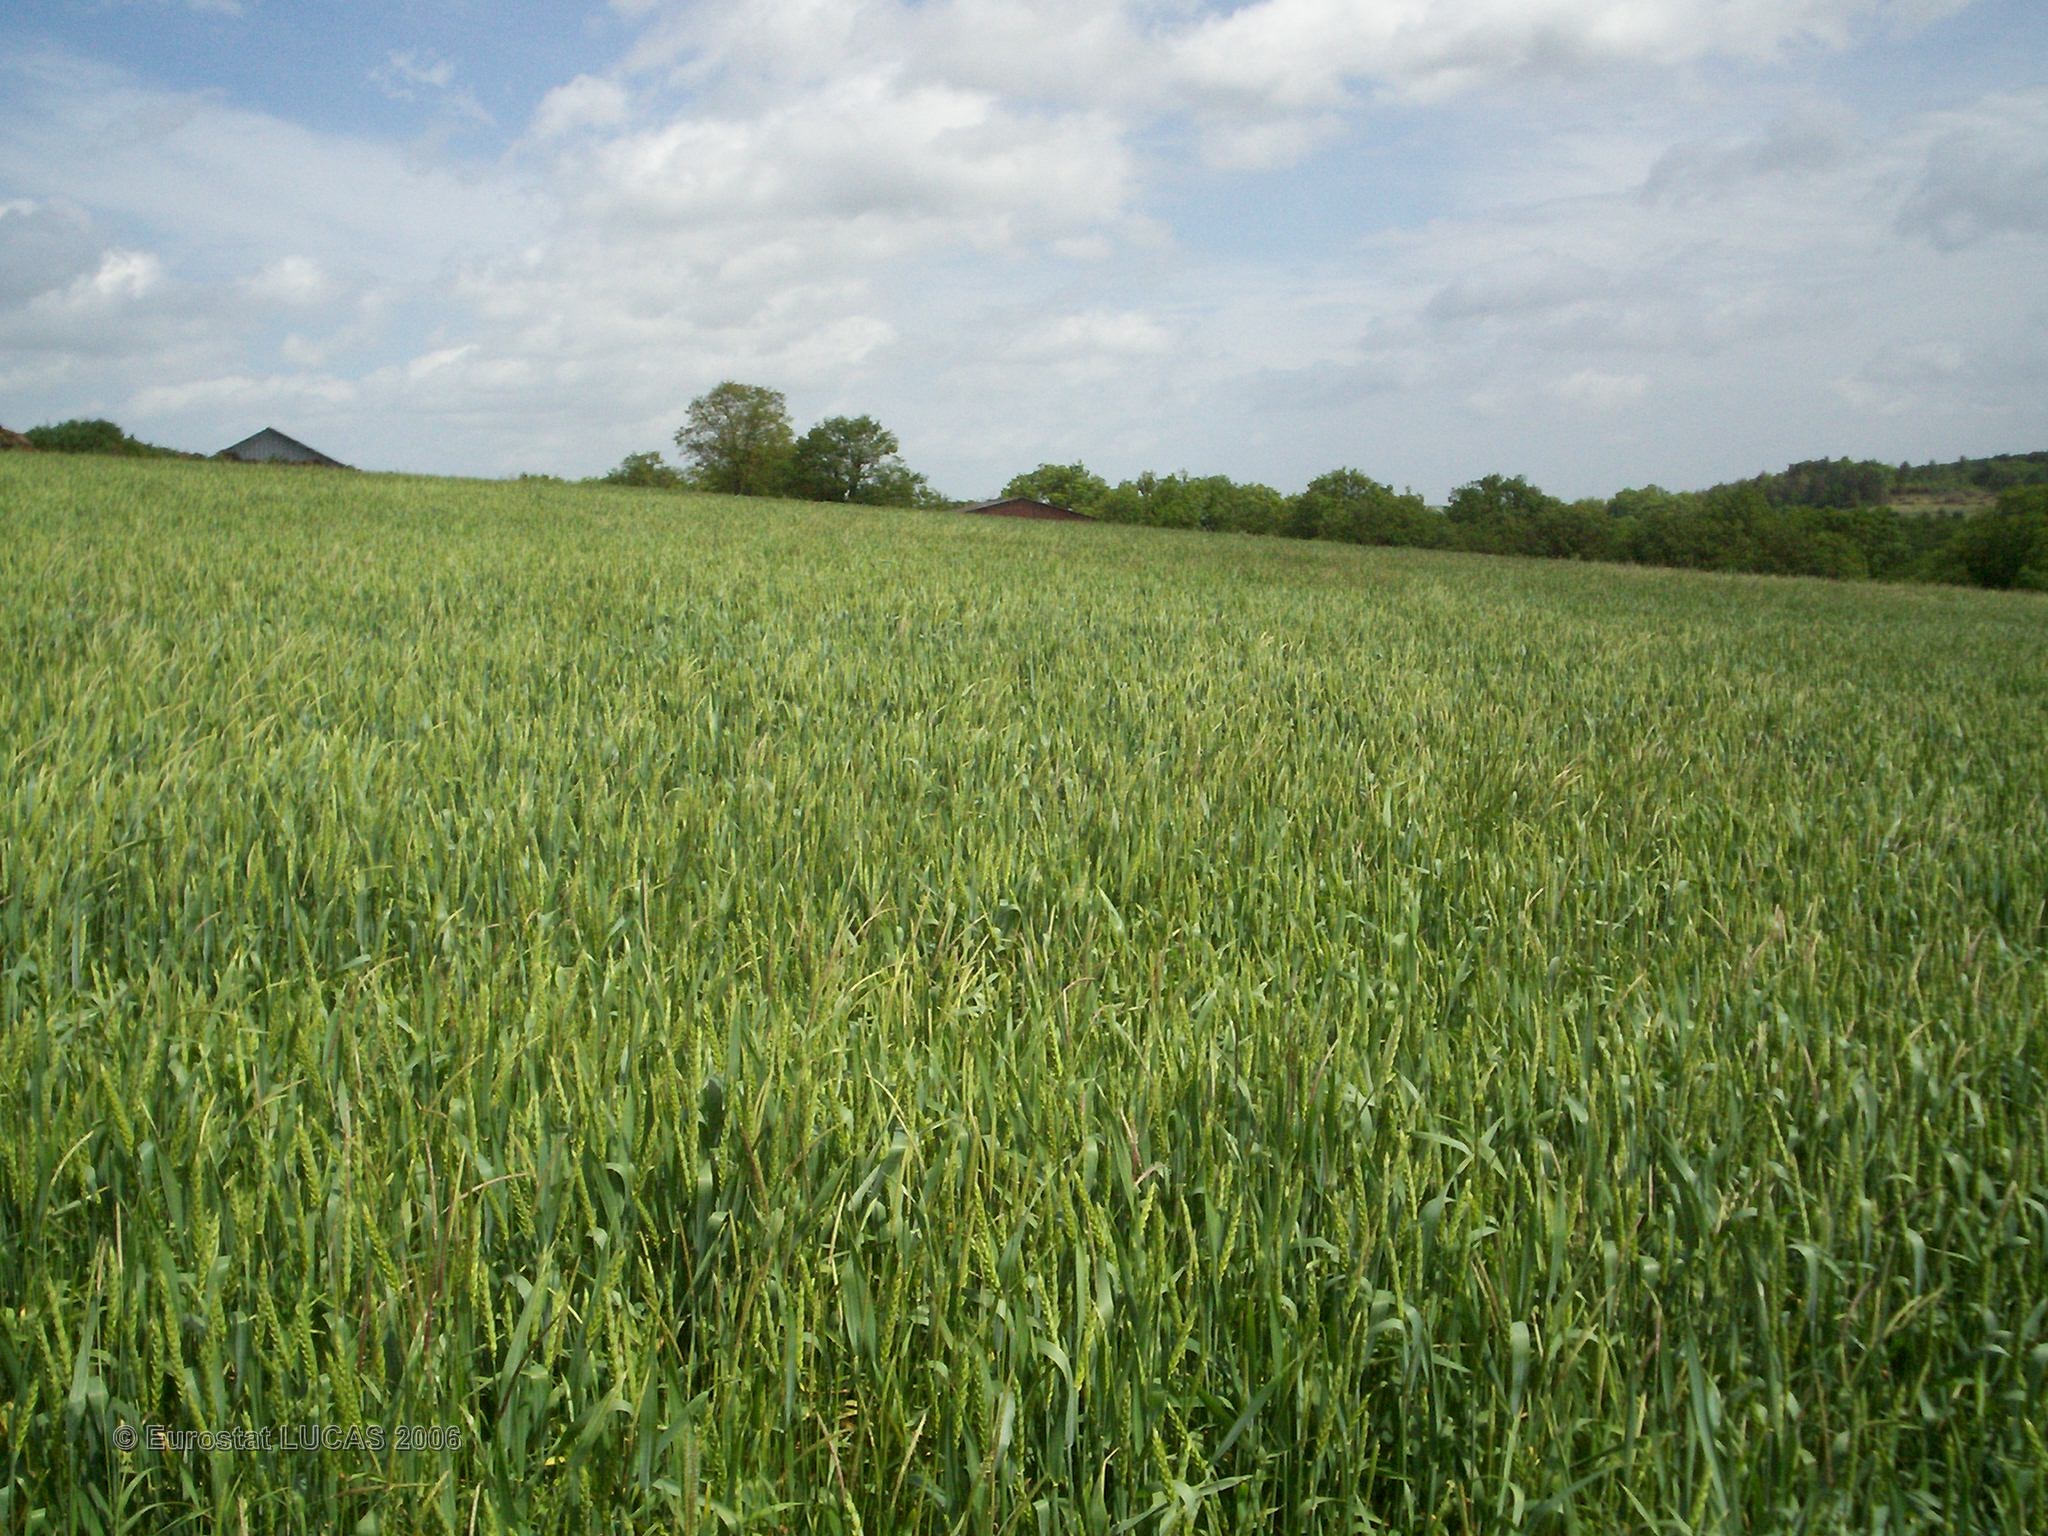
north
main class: Cropland
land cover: Durum wheat
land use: Agriculture (excluding fallow land and kitchen gardens)
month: May
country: FR
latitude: 47.6627
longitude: 3.9918
